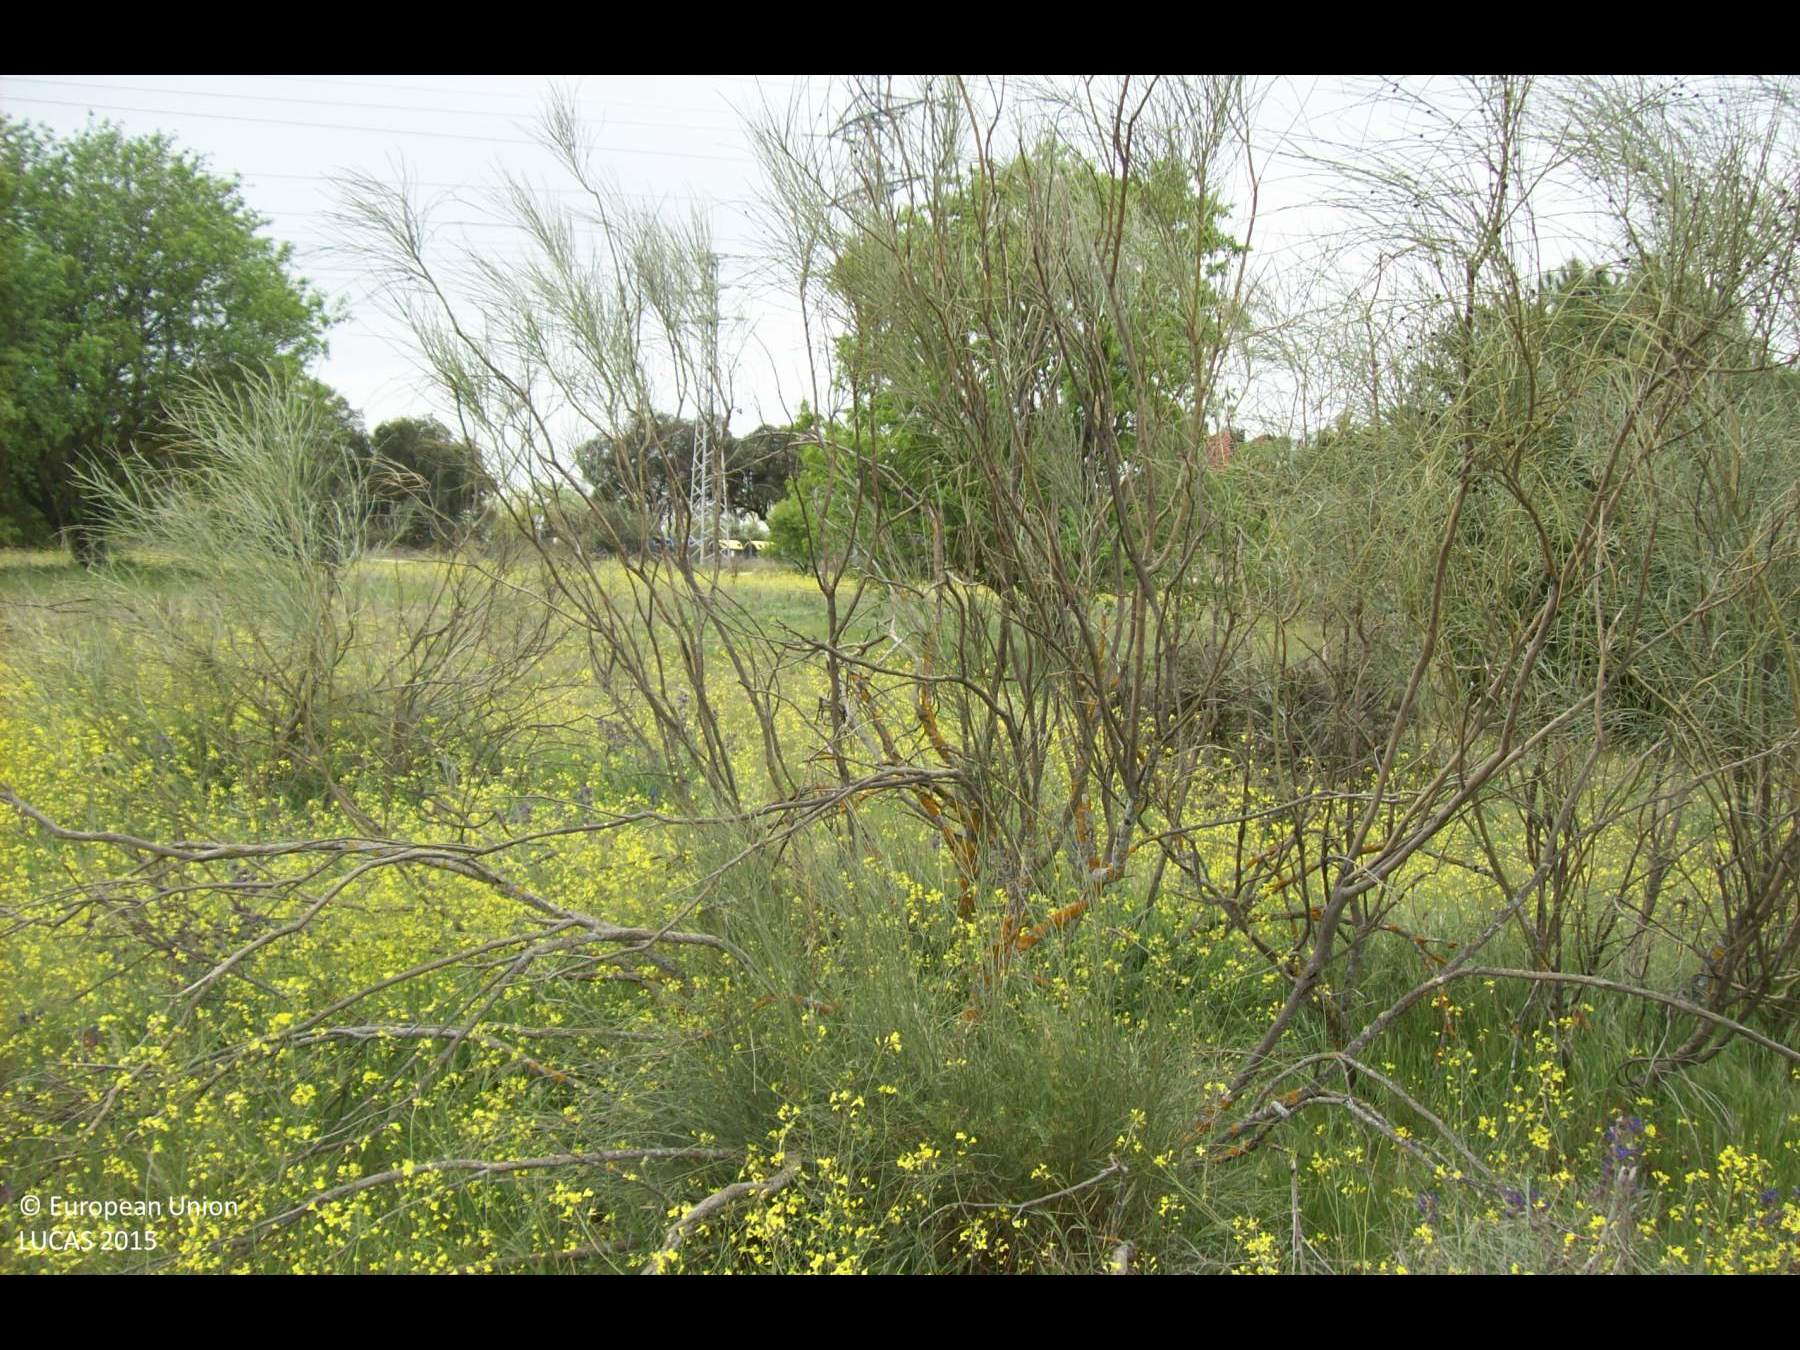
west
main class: Grassland
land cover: Grassland with sparse tree/shrub cover
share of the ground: > 75 %
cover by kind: herbaceous plants 85 %, shrubs 10 %, broadleaved forest trees 5 %
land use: Semi-natural and natural areas not in use
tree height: < 5 m
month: April
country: ES
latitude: 40.4350
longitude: -3.8439
